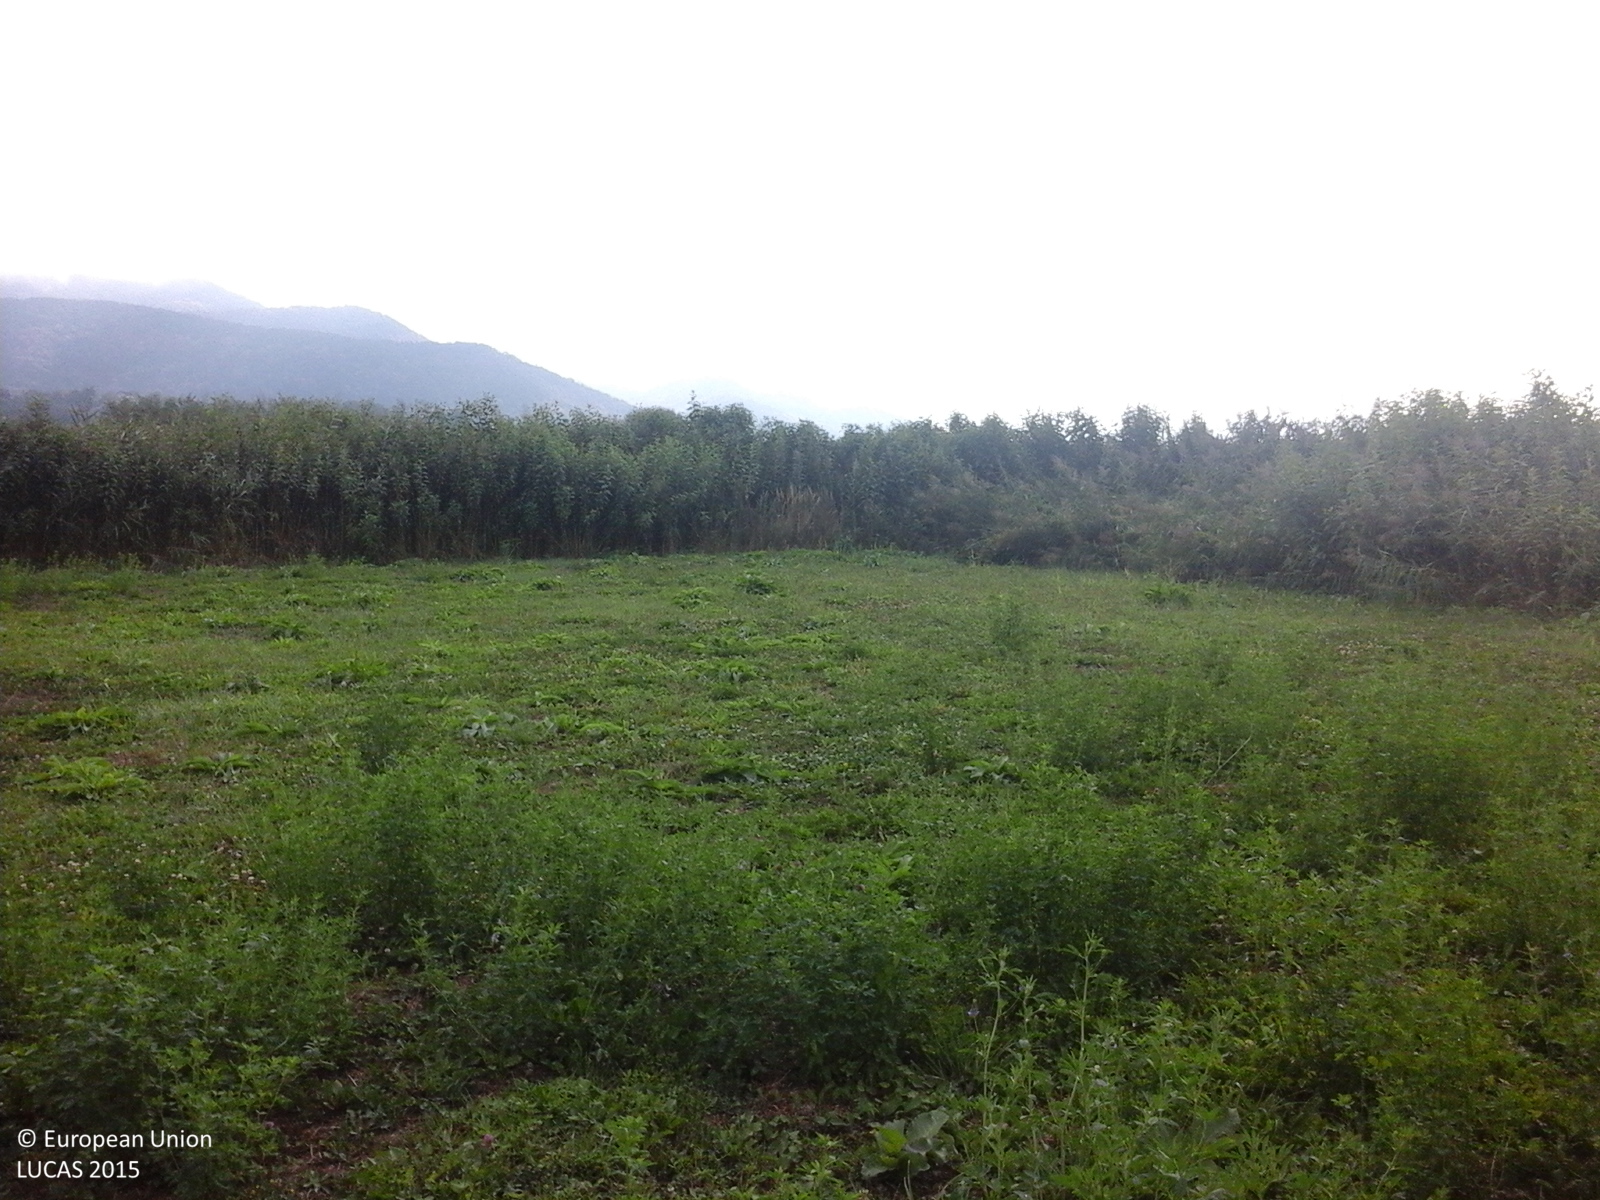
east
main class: Cropland
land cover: Lucerne
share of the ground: > 75 %
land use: Agriculture (excluding fallow land and kitchen gardens)
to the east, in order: Lucerne; Shruby margins; Rivers and streams; Shruby margins; Spontaneously vegetated surfaces; Maize; Common wheat; Shruby margins; Ditches and canals; Spontaneously vegetated surfaces
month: September
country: RO
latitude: 47.6947
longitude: 23.3839
